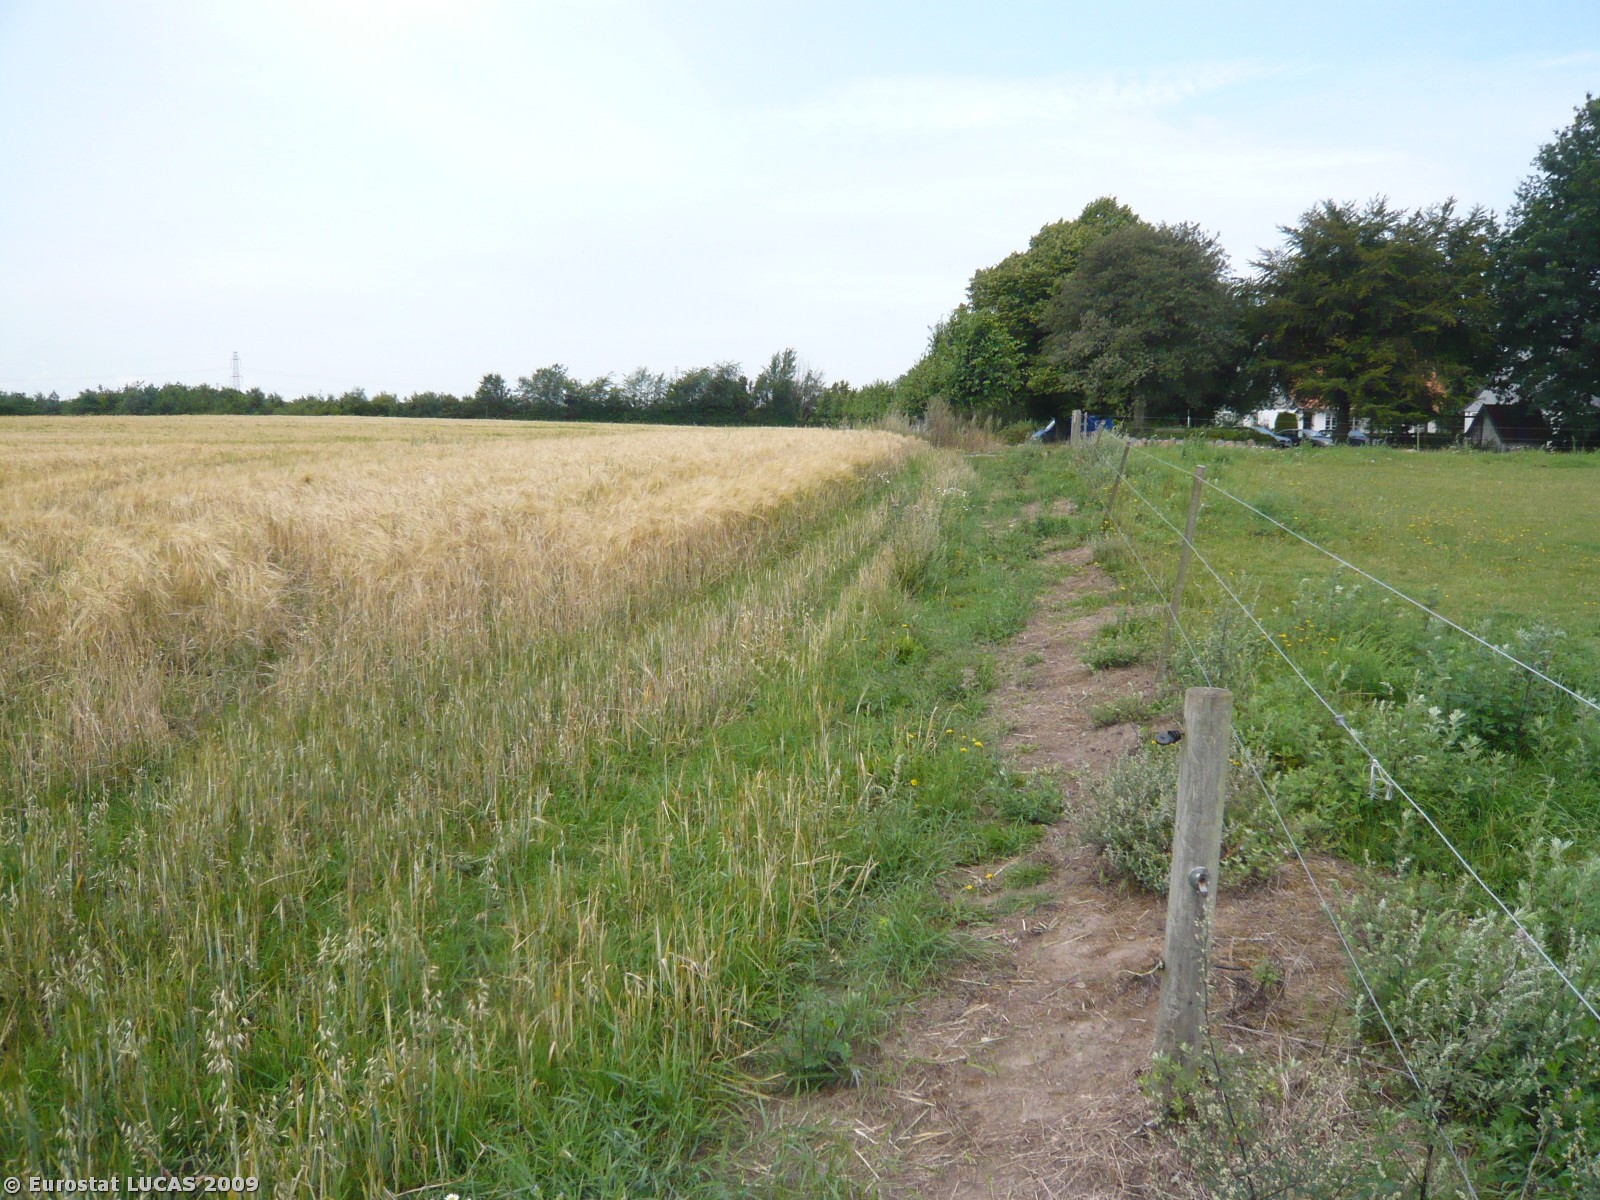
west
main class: Grassland
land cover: Grassland without tree/shrub cover
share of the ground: > 75 %
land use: Agriculture (excluding fallow land and kitchen gardens)
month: July
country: DK
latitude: 55.8095
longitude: 12.1841
